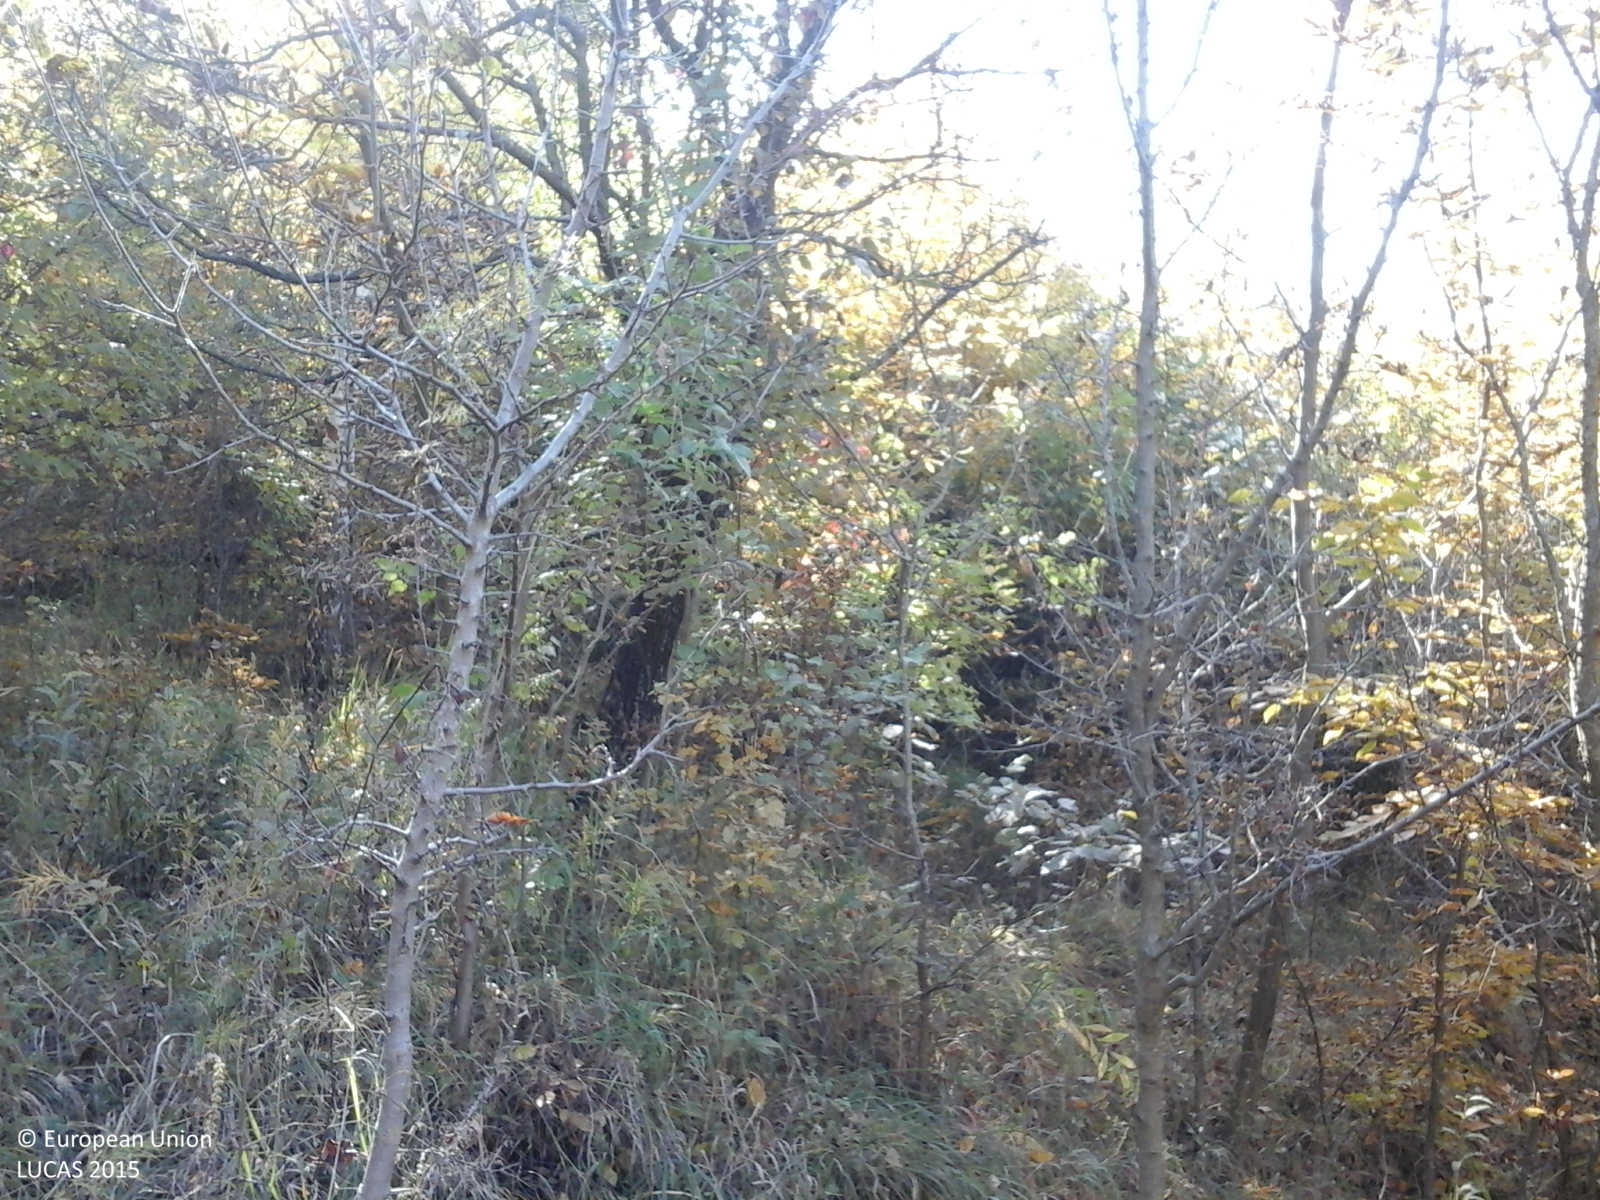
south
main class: Grassland
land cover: Grassland with sparse tree/shrub cover
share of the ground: > 75 %
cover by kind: herbaceous plants 85 %, shrubs 10 %, broadleaved forest trees 5 %
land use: Fallow land
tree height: < 5 m
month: October
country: RO
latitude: 45.1069
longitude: 26.4262
